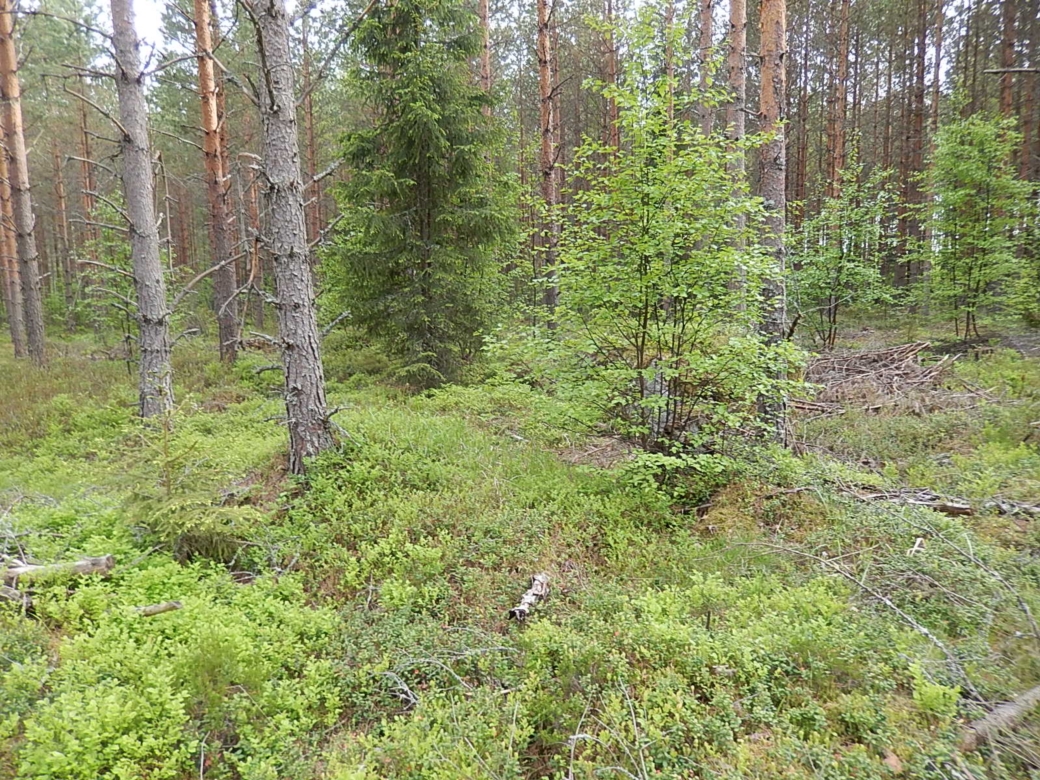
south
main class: Woodland
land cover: Pine dominated coniferous woodland
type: boreal forest
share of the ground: > 75 %
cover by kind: coniferous forest trees 70 %, broadleaved forest trees 10 %, shrubs 10 %, herbaceous plants 10 %
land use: Forestry
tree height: > 5 m
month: June
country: FI
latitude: 61.8860
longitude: 21.6342
